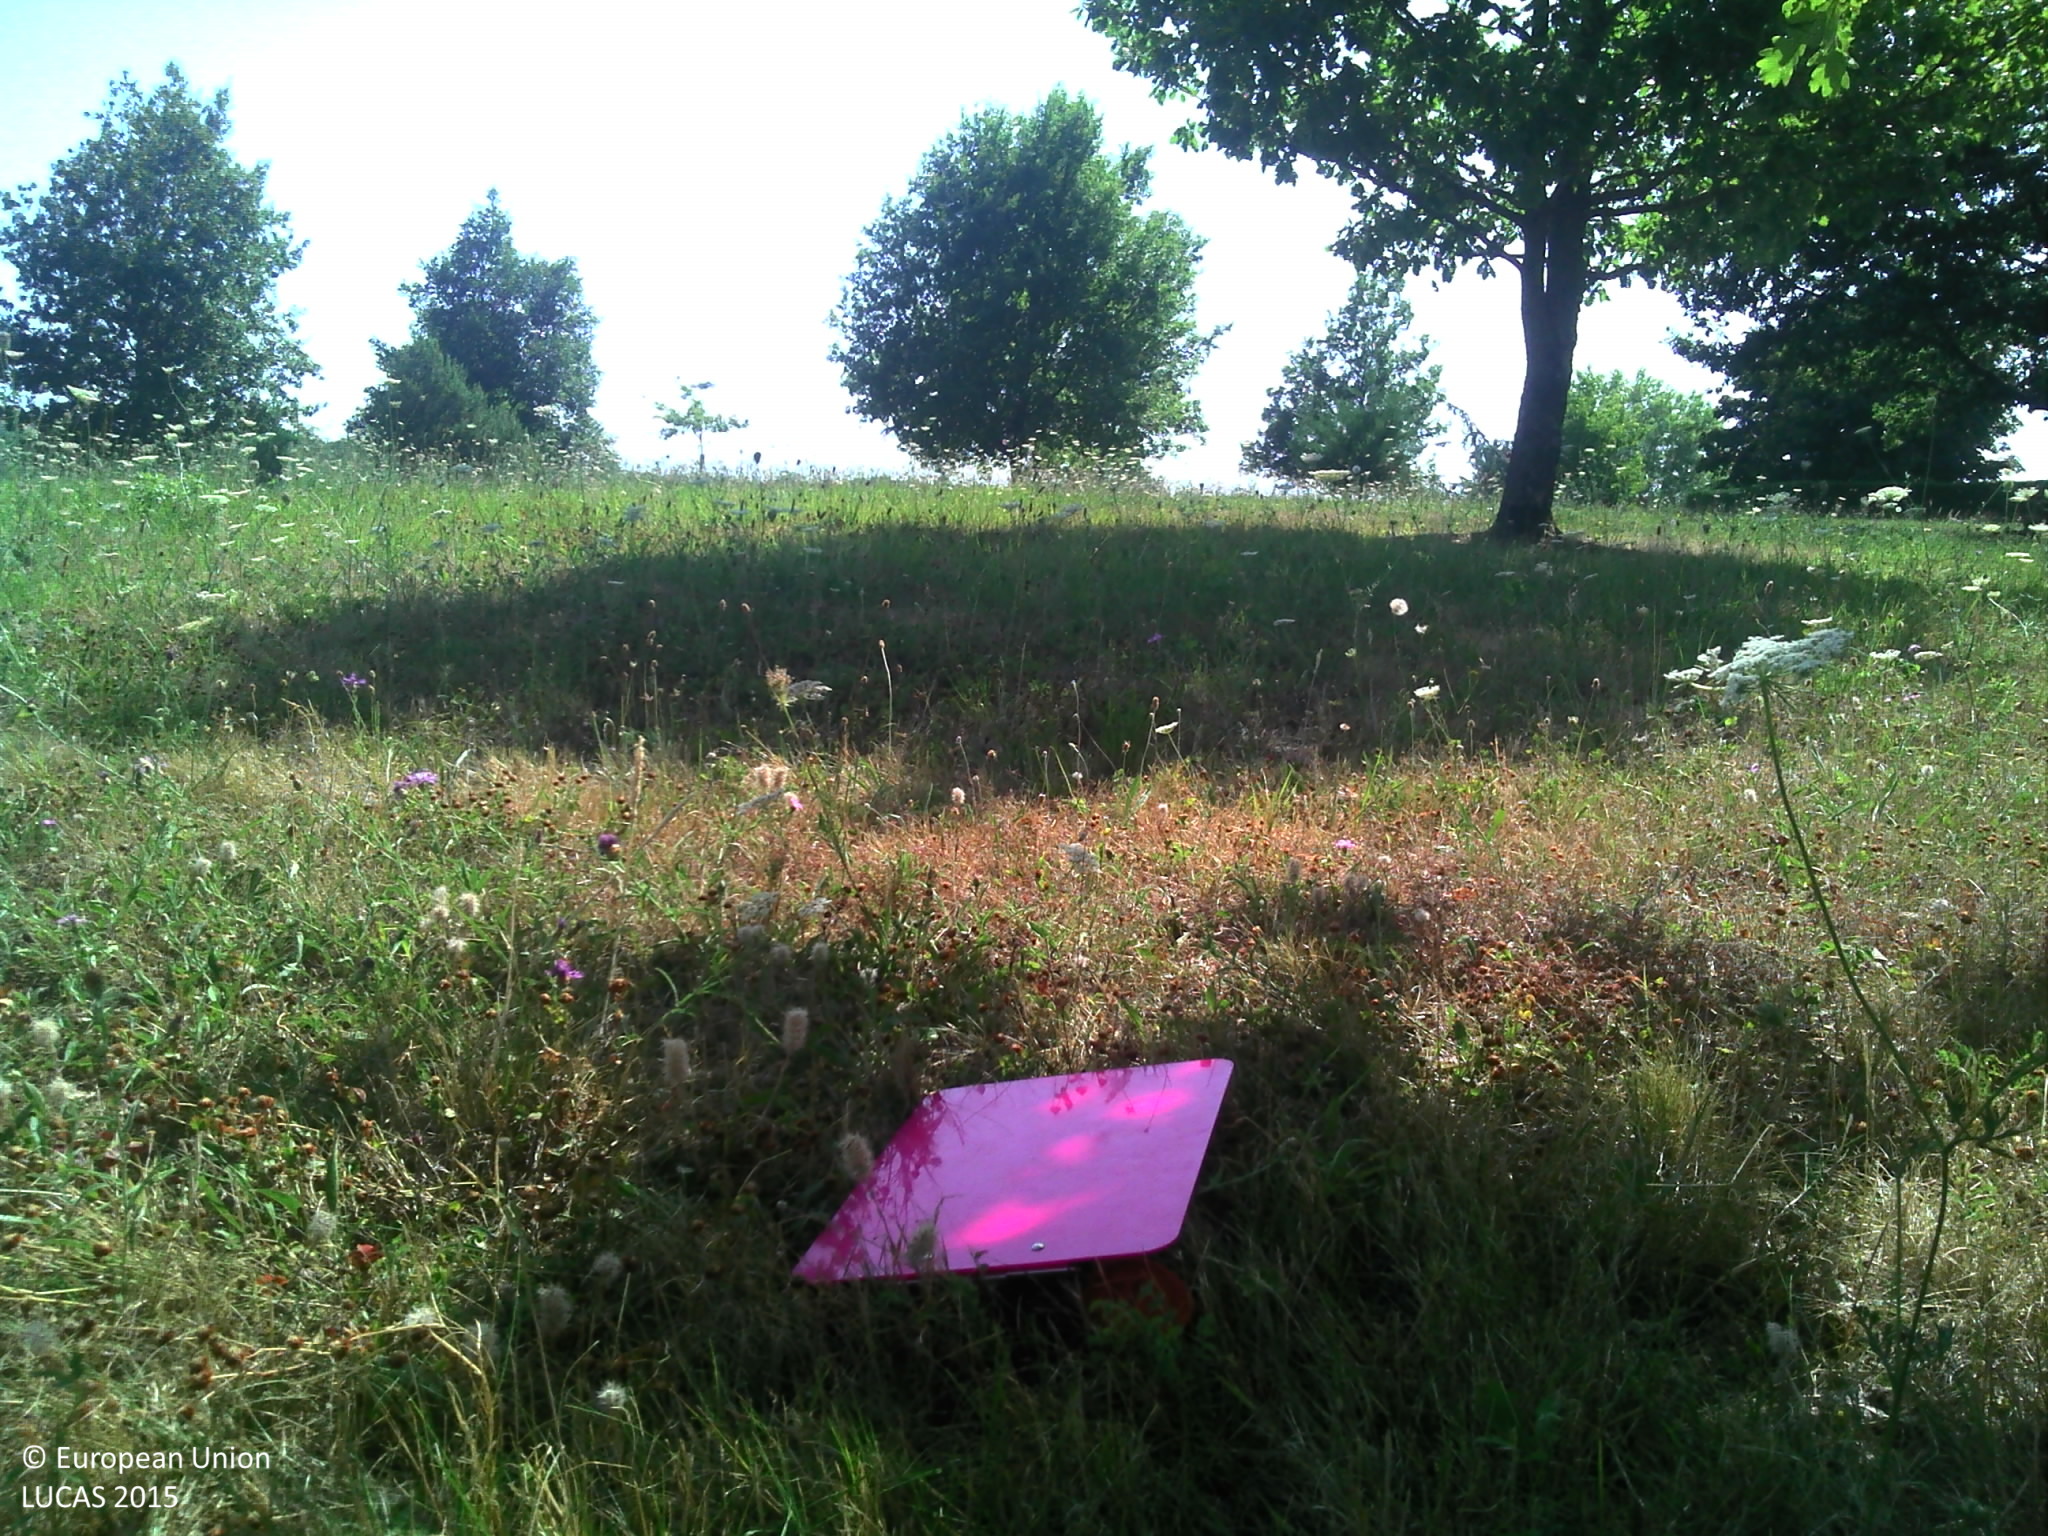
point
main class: Grassland
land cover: Grassland with sparse tree/shrub cover
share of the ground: > 75 %
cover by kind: herbaceous plants 95 %, broadleaved forest trees 5 %
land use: Agriculture (excluding fallow land and kitchen gardens)
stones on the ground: < 10 %
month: August
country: FR
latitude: 44.1507
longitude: 1.3348
